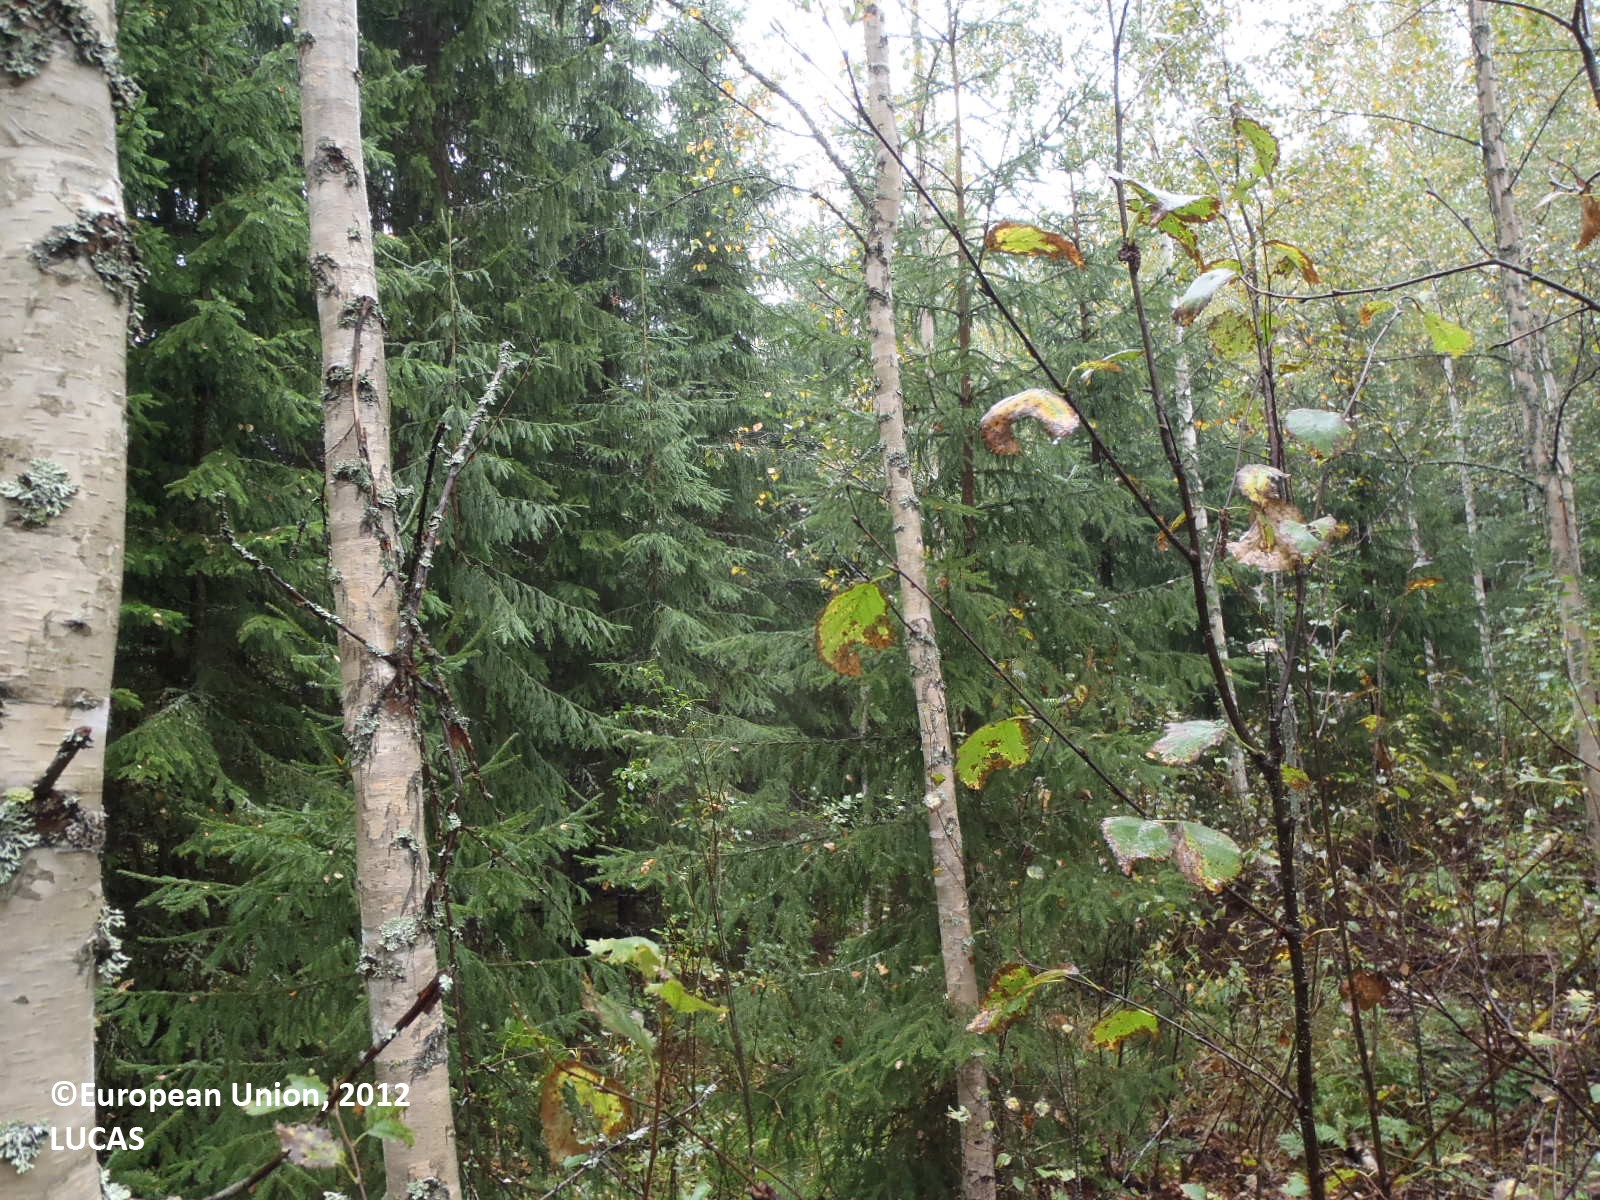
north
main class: Woodland
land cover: Broadleaved woodland
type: boreal forest
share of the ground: > 75 %
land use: Forestry
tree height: > 5 m
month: September
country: FI
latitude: 61.6049
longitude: 22.5995
